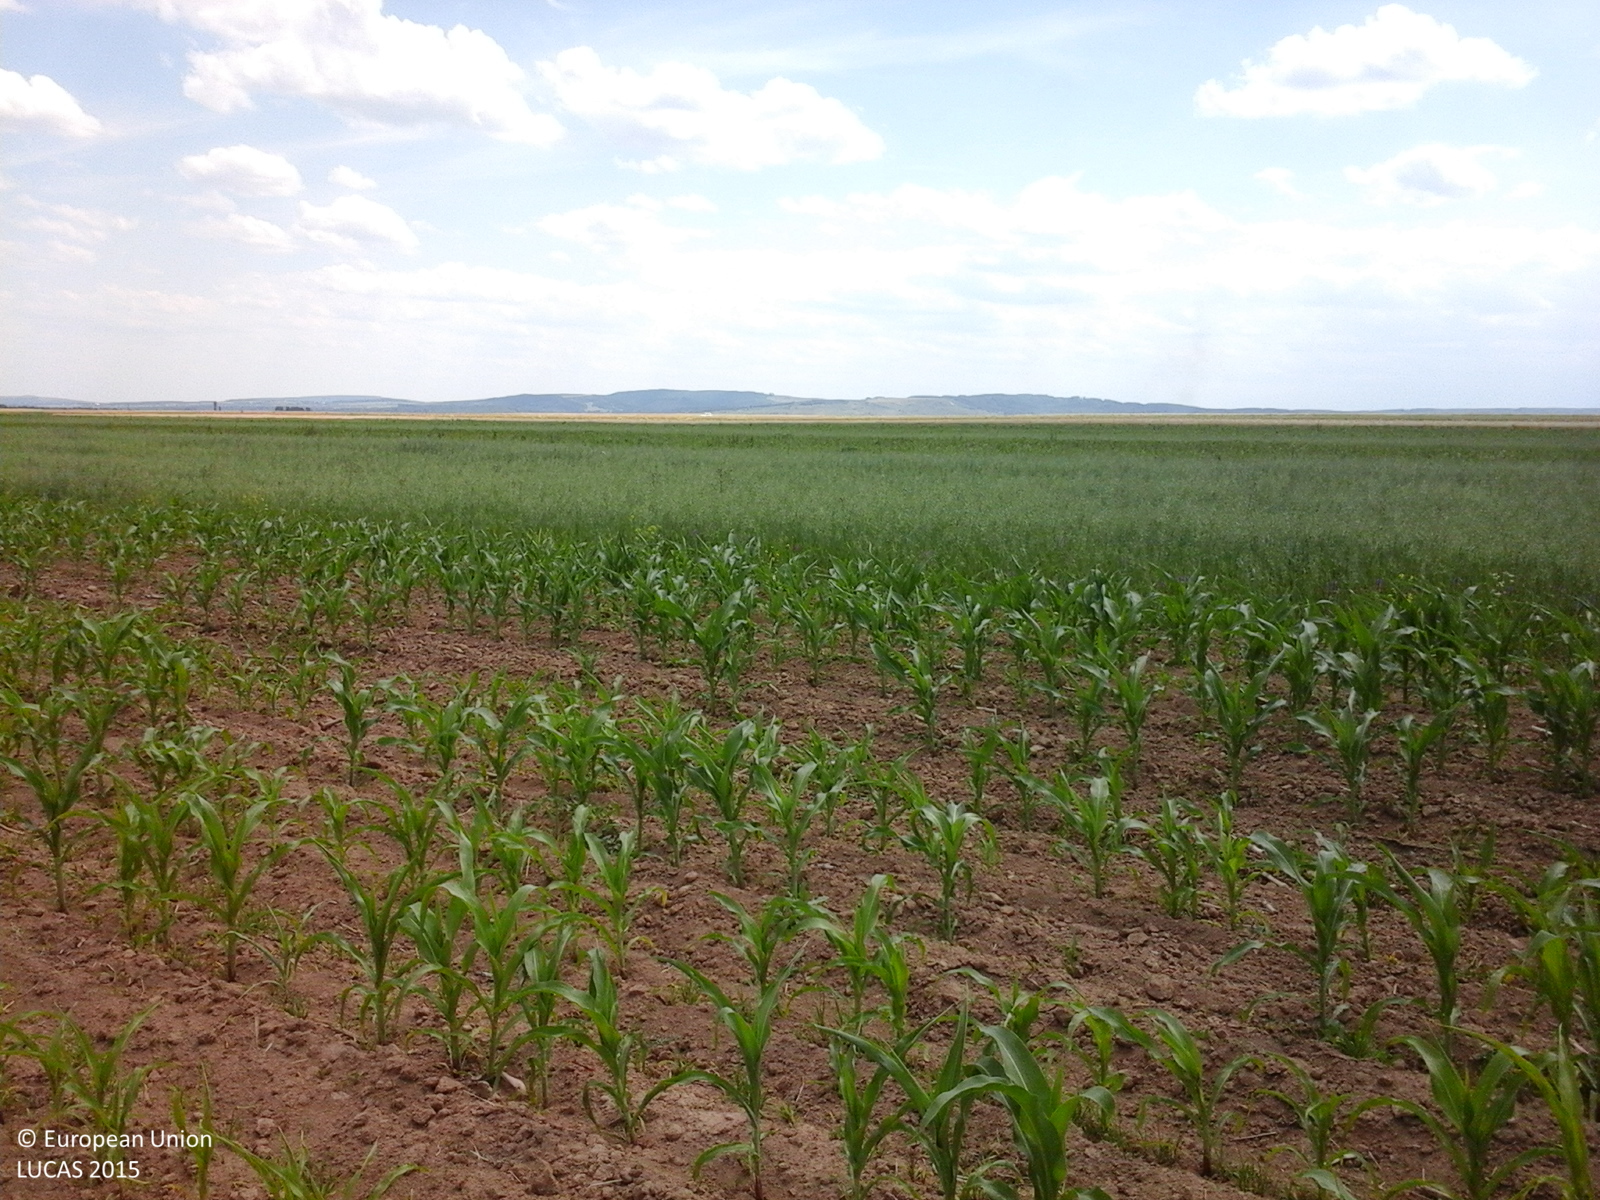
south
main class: Cropland
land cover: Maize
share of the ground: 25 - 50 %
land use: Agriculture (excluding fallow land and kitchen gardens)
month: June
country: RO
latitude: 47.6381
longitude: 26.4464
